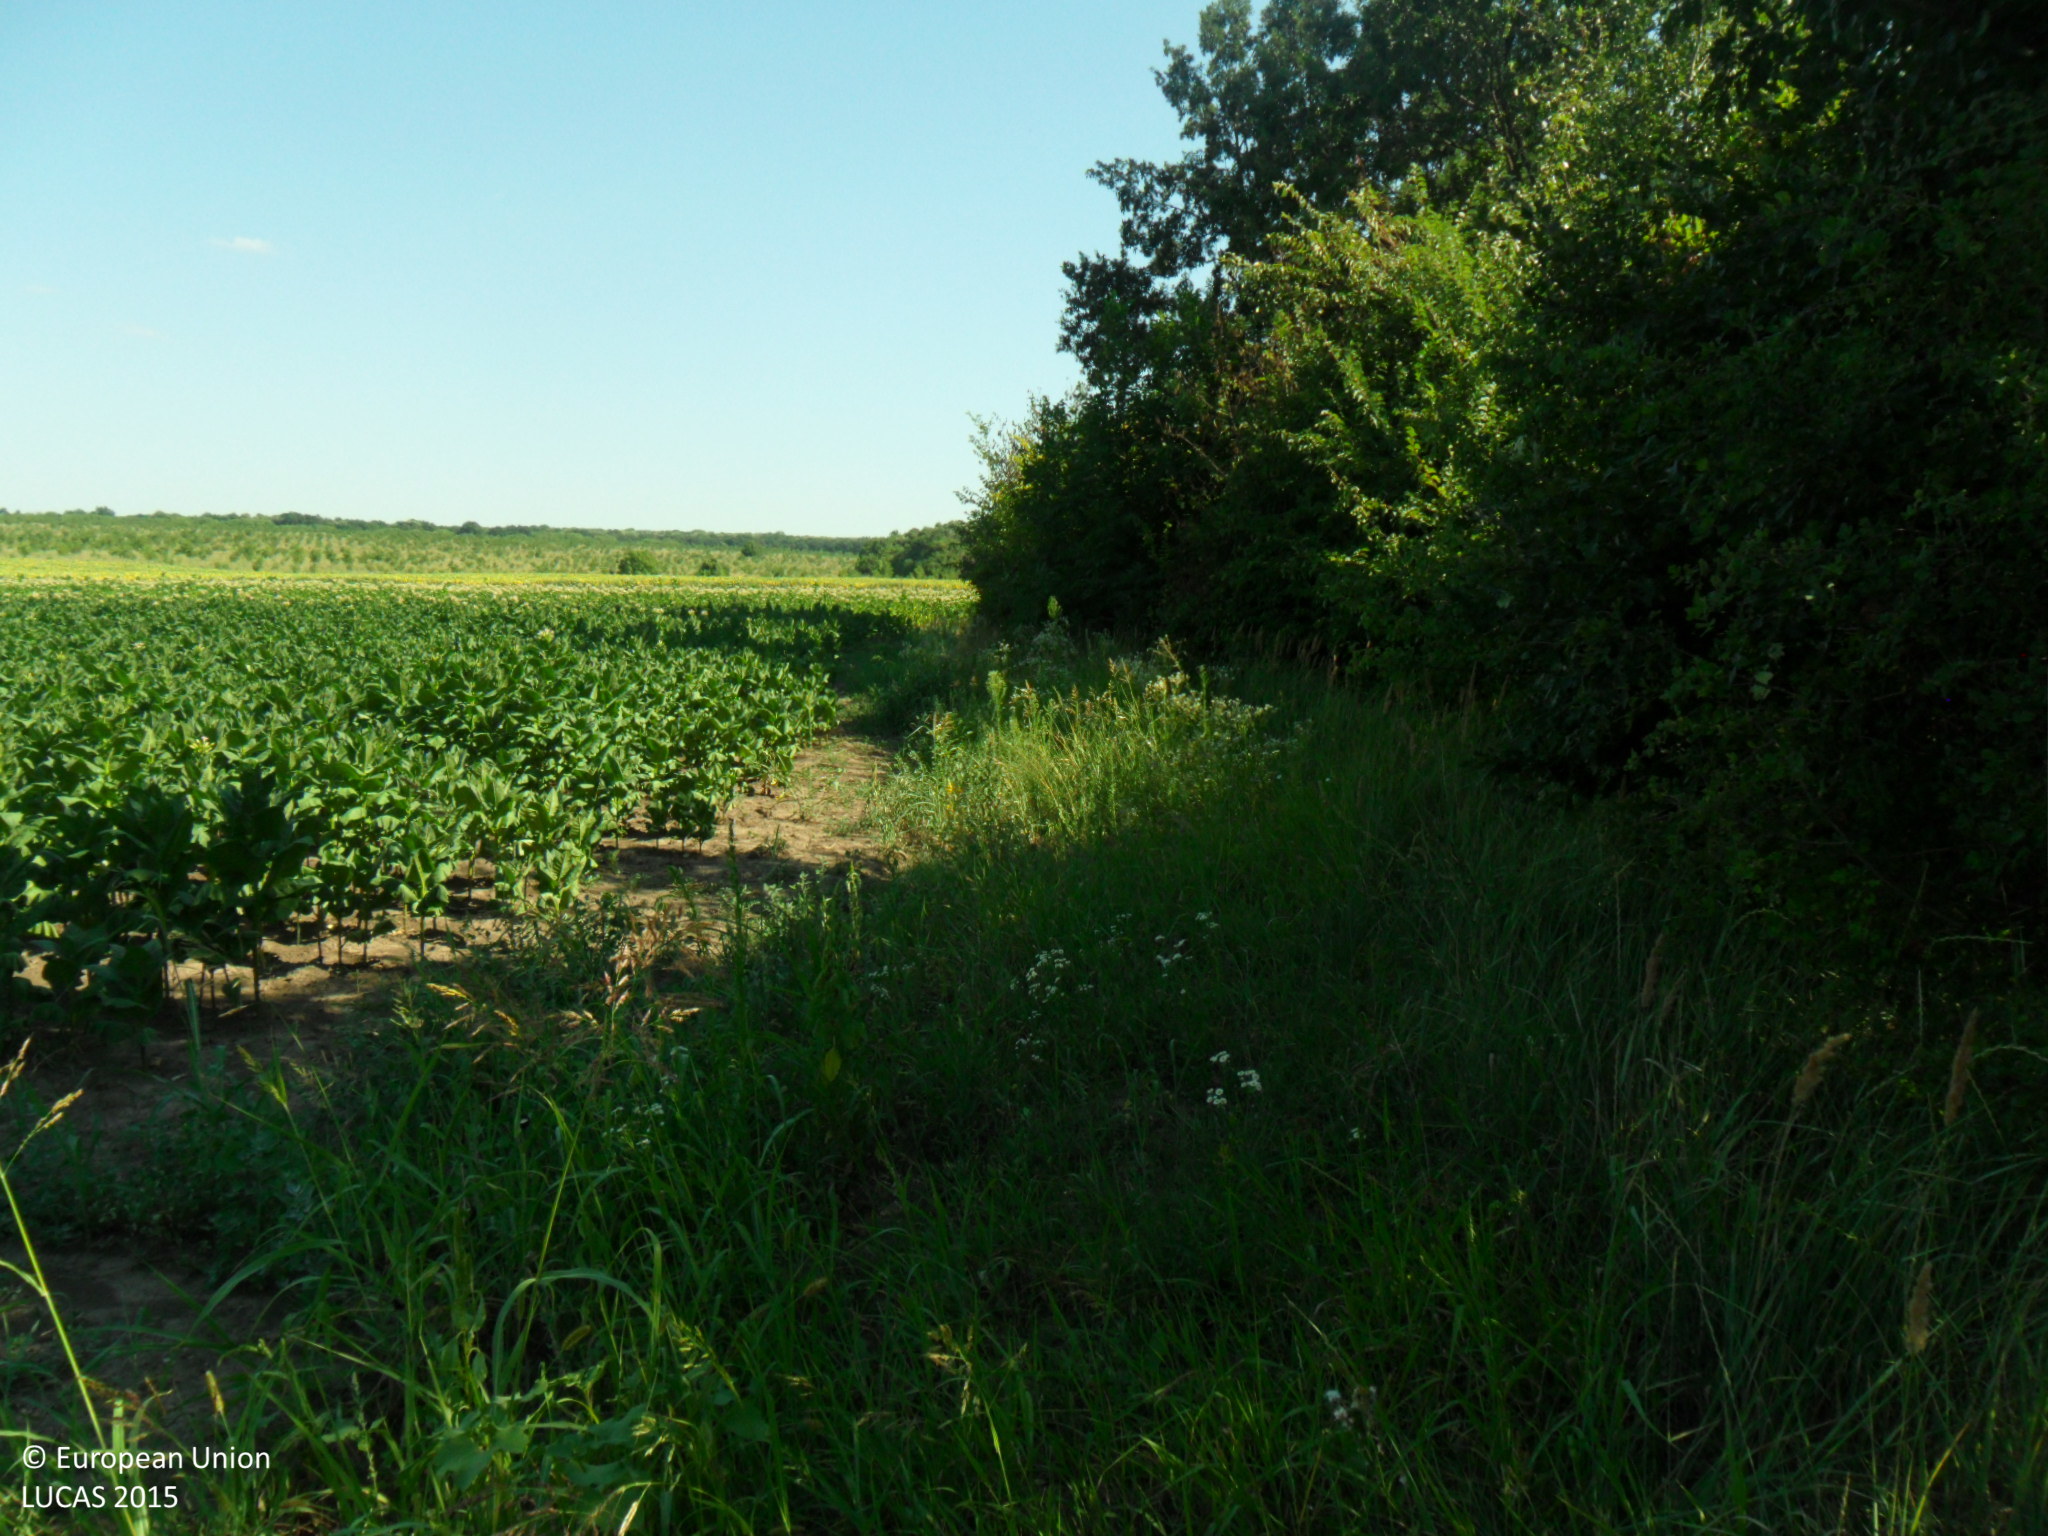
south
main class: Shrubland
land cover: Shrubland with sparse tree cover
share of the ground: > 75 %
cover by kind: shrubs 80 %, herbaceous plants 15 %, broadleaved forest trees 5 %
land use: Agriculture (excluding fallow land and kitchen gardens)
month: July
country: BG
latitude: 43.8337
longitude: 26.4611
